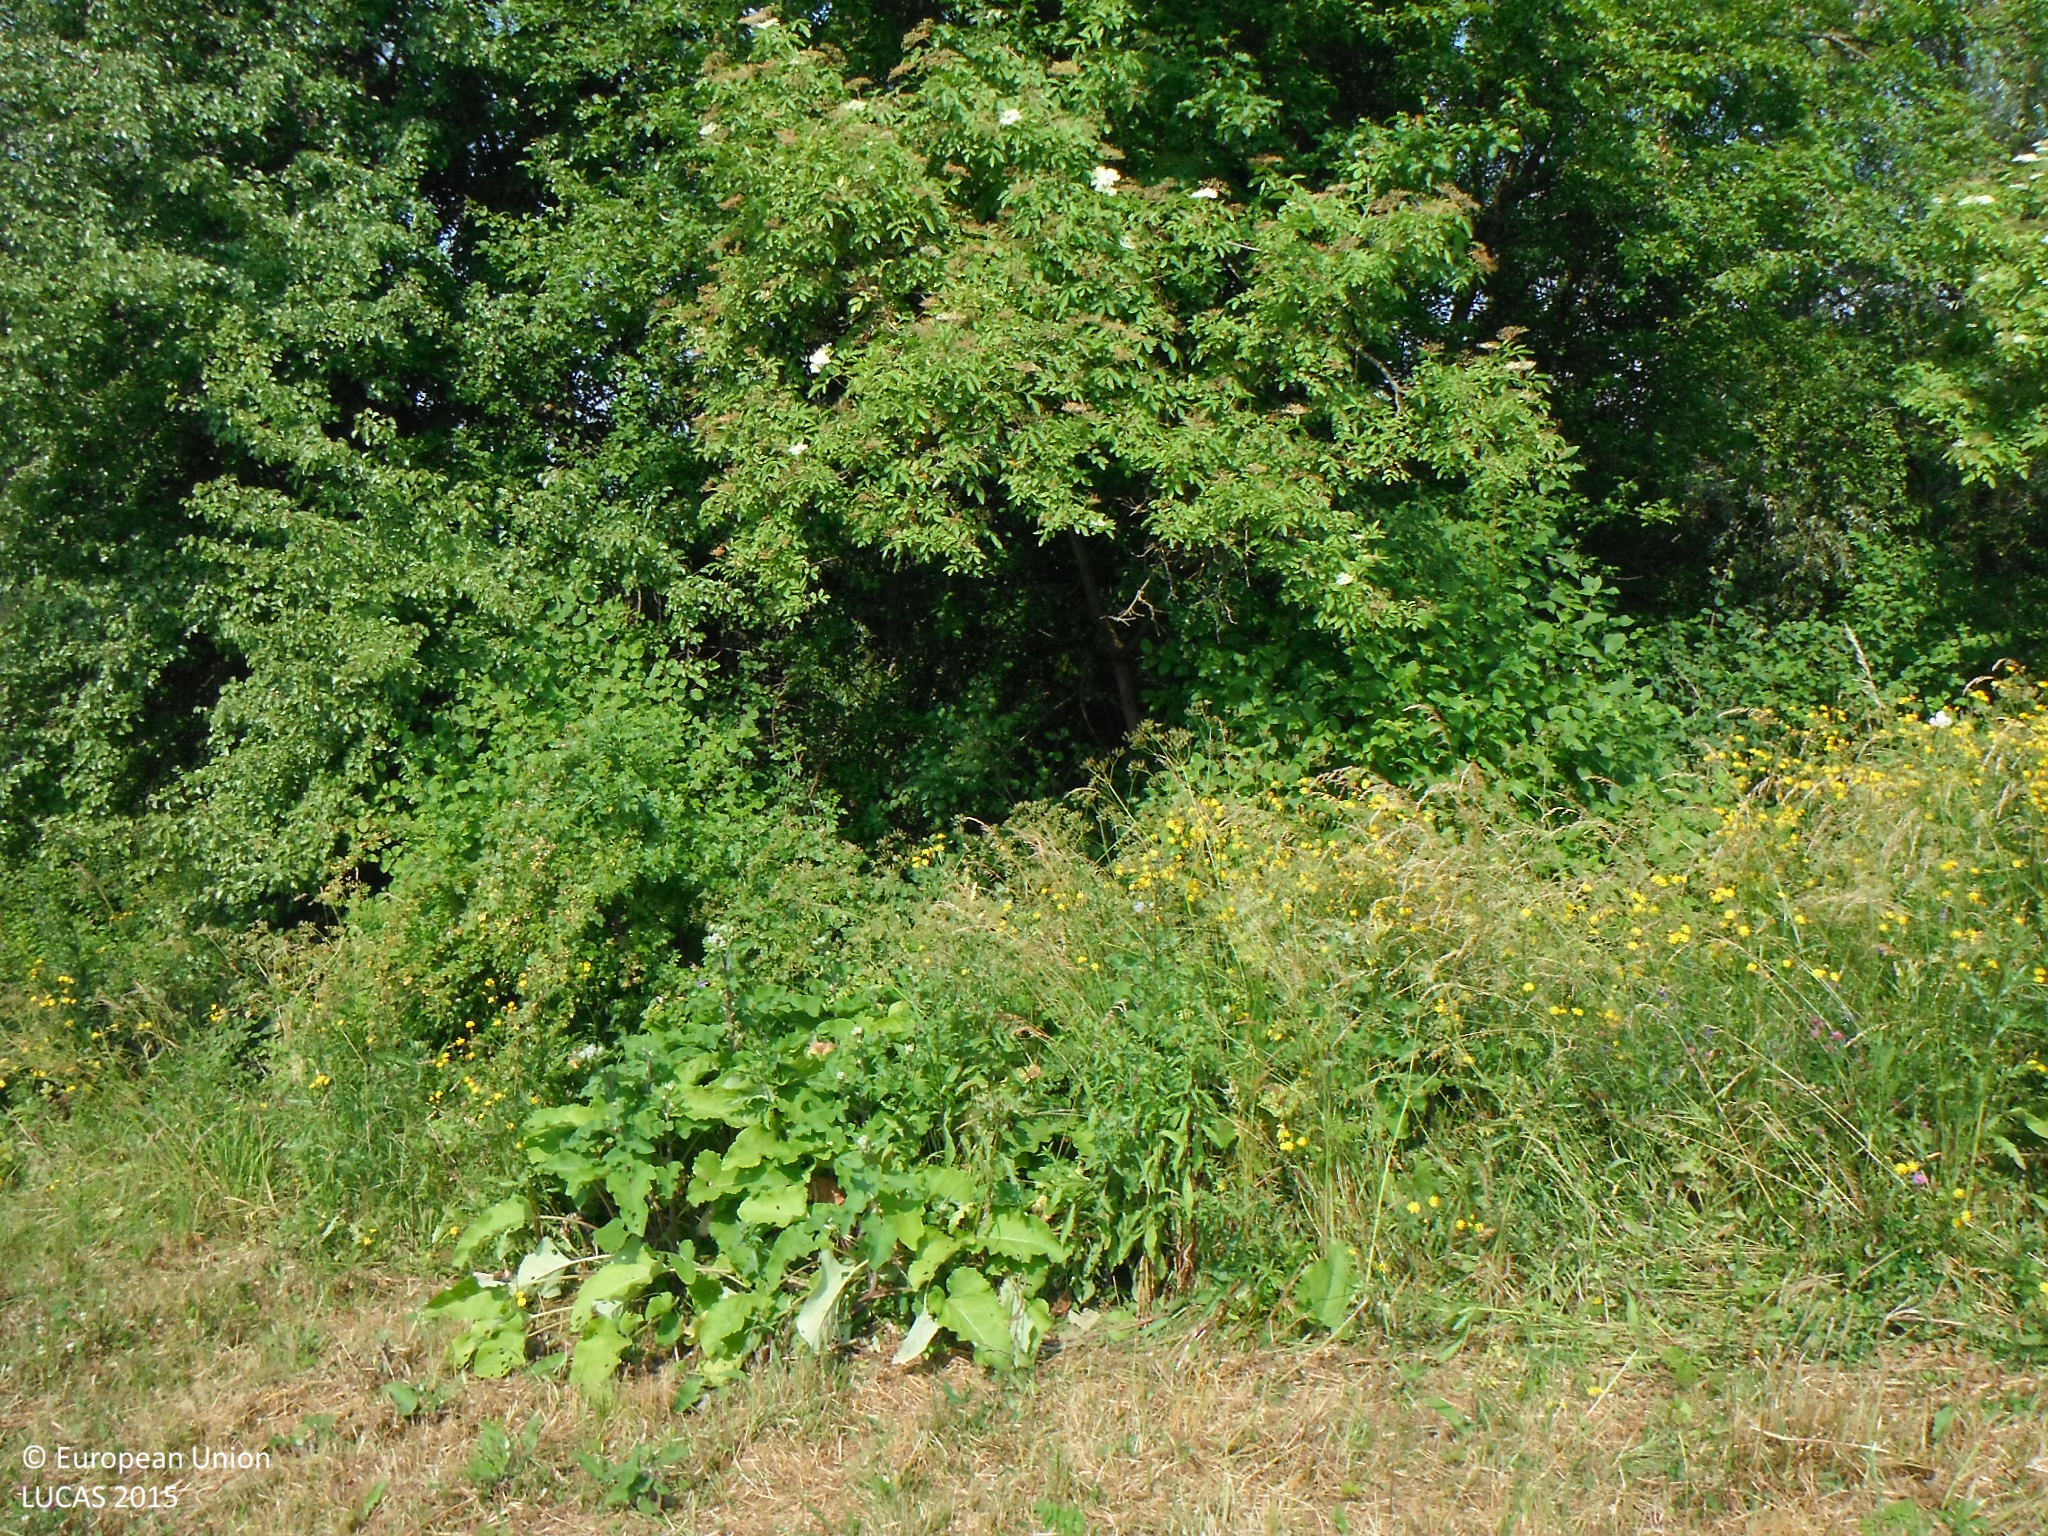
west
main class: Grassland
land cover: Grassland without tree/shrub cover
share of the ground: > 75 %
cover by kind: herbaceous plants 100 %
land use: Agriculture (excluding fallow land and kitchen gardens)
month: July
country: SK
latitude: 49.1017
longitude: 19.4629
